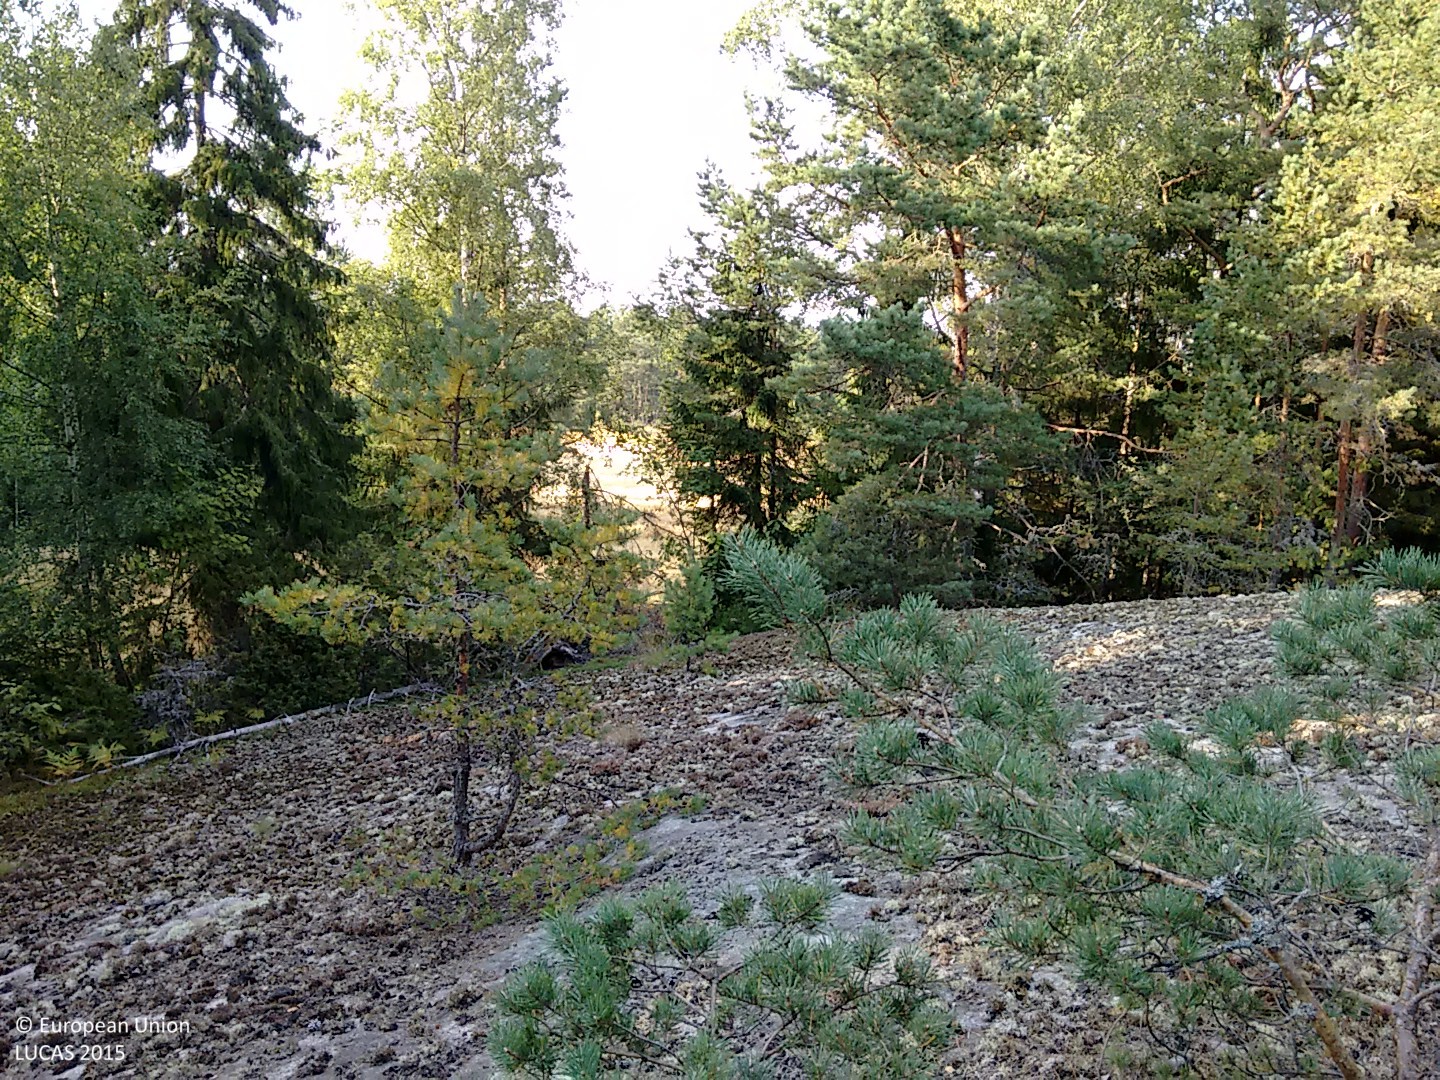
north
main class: Woodland
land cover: Pine dominated coniferous woodland
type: hemiboreal forest and nemoral coniferous forest and mixed broadleaved-coniferous forest
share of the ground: 50 - 75 %
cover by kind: coniferous forest trees 70 %, lichens and mosses 20 %, shrubs 10 %
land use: Forestry
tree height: > 5 m
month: August
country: FI
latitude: 60.0235
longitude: 20.5092
